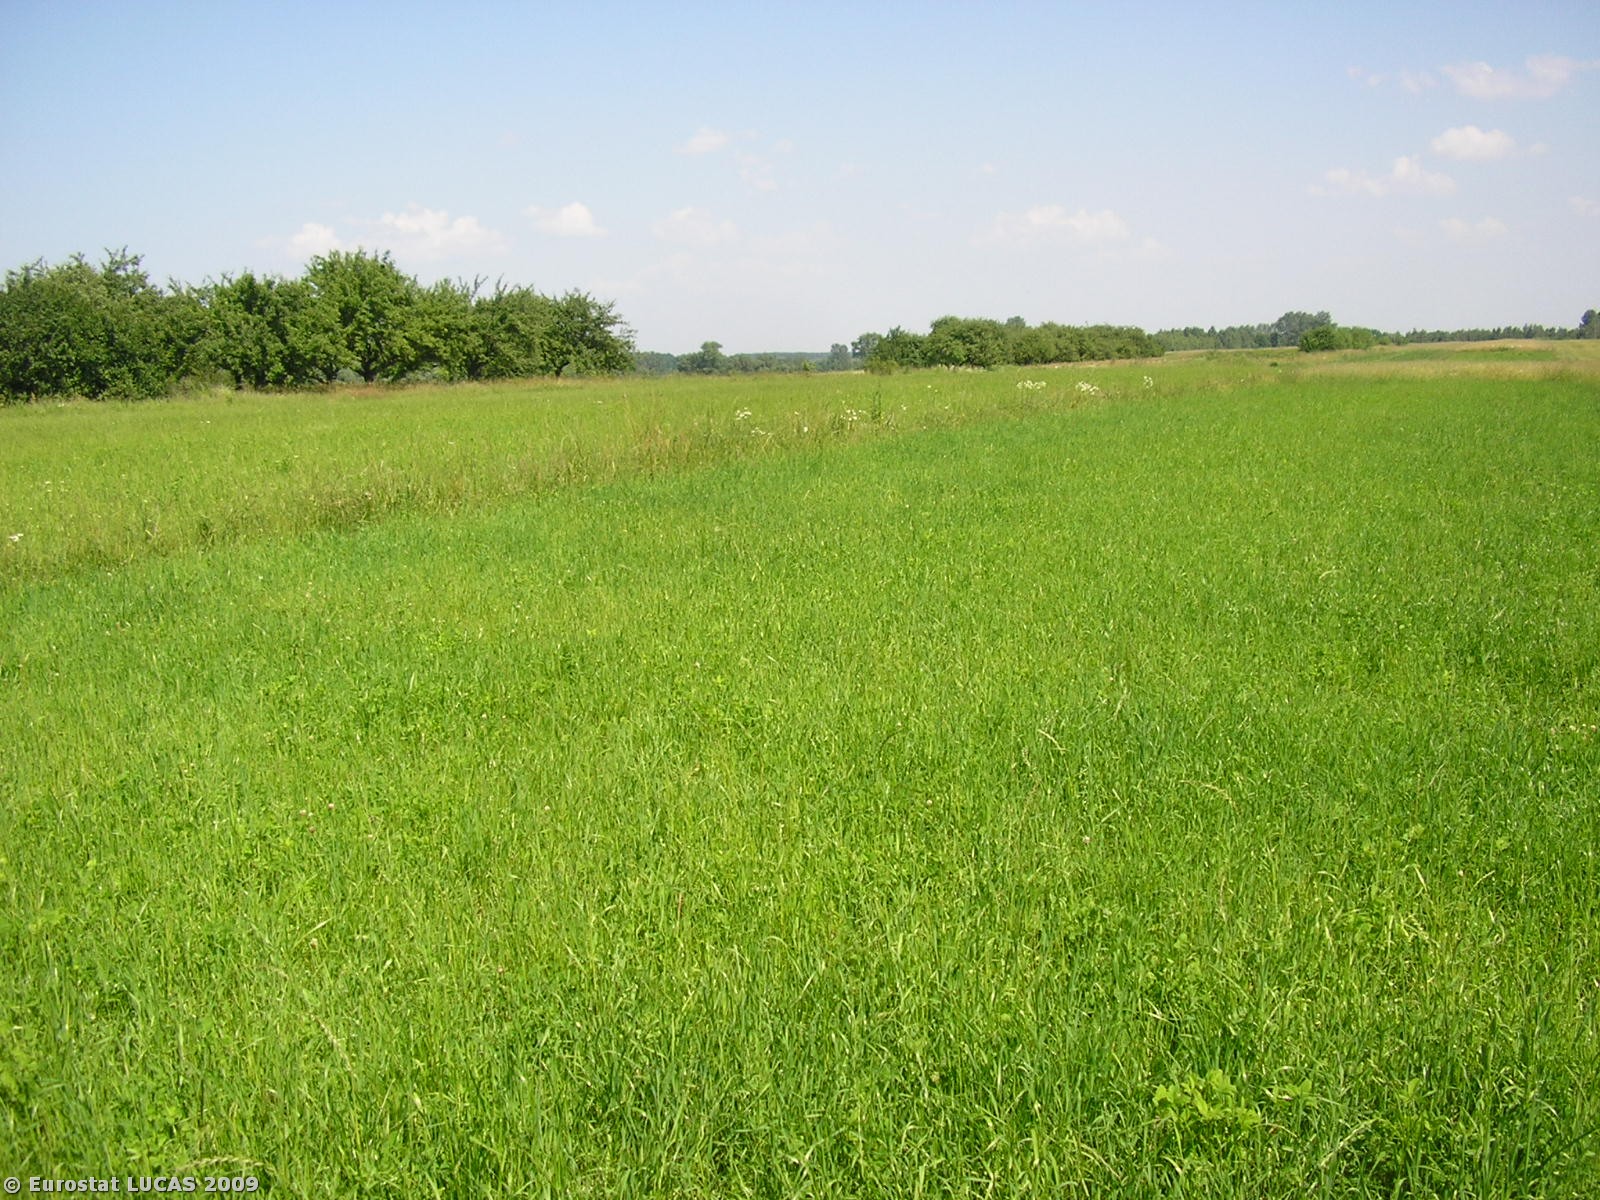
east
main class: Grassland
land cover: Grassland without tree/shrub cover
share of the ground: > 75 %
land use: Agriculture (excluding fallow land and kitchen gardens)
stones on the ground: < 10 %
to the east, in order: Grassland without tree/shrub cover; Tracks; Grassland without tree/shrub cover; Spontaneously vegetated surfaces; Tracks; Grass margins; Other fresh vegetables
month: July
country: PL
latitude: 50.3978
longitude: 20.7750
